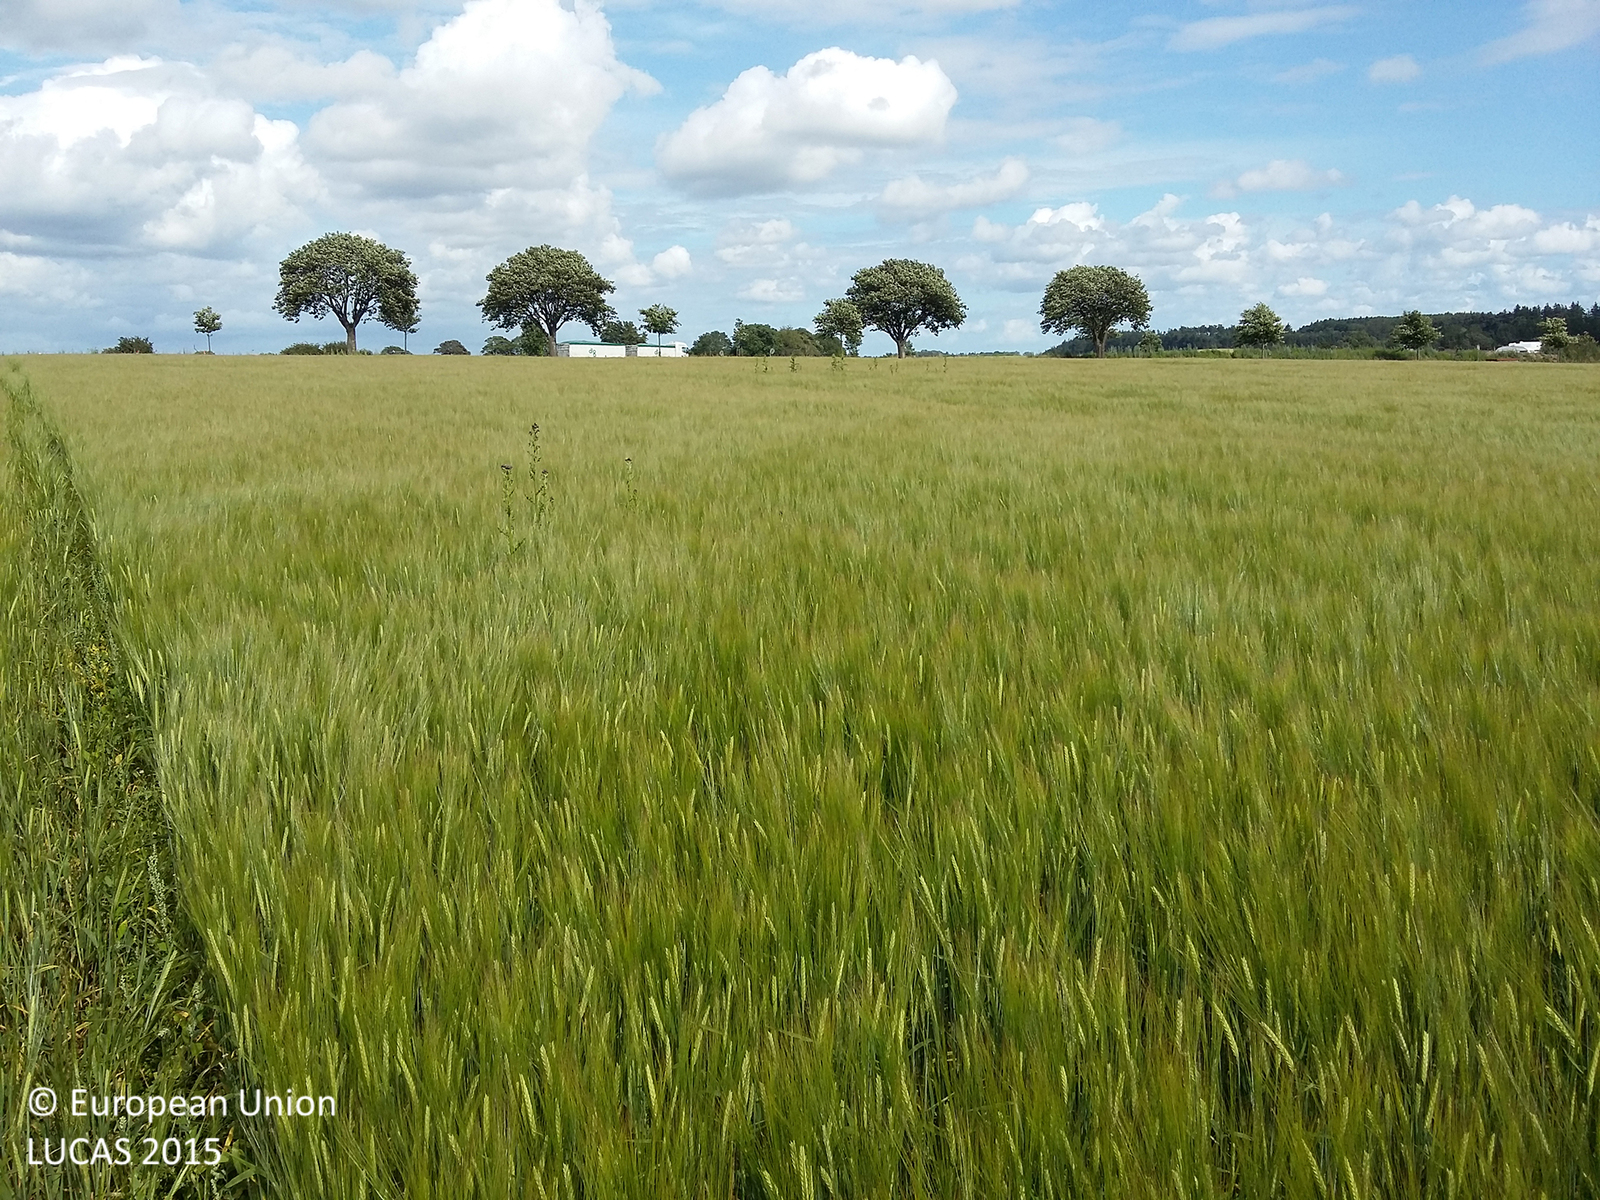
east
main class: Cropland
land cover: Barley
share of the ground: > 75 %
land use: Agriculture (excluding fallow land and kitchen gardens)
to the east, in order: Barley; Grass margins; Lines of trees; Paved roads, cycling and walking lanes; Lines of trees; Grass margins; Fences; Barley; Fences; Grass margins; Paved roads, cycling and walking lanes; Grass margins; Paved roads, cycling and walking lanes; Grass margins; Paved roads, cycling and walking lanes; Spontaneously vegetated surfaces; Barley
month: July
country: DK
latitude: 55.1867
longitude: 11.7735
